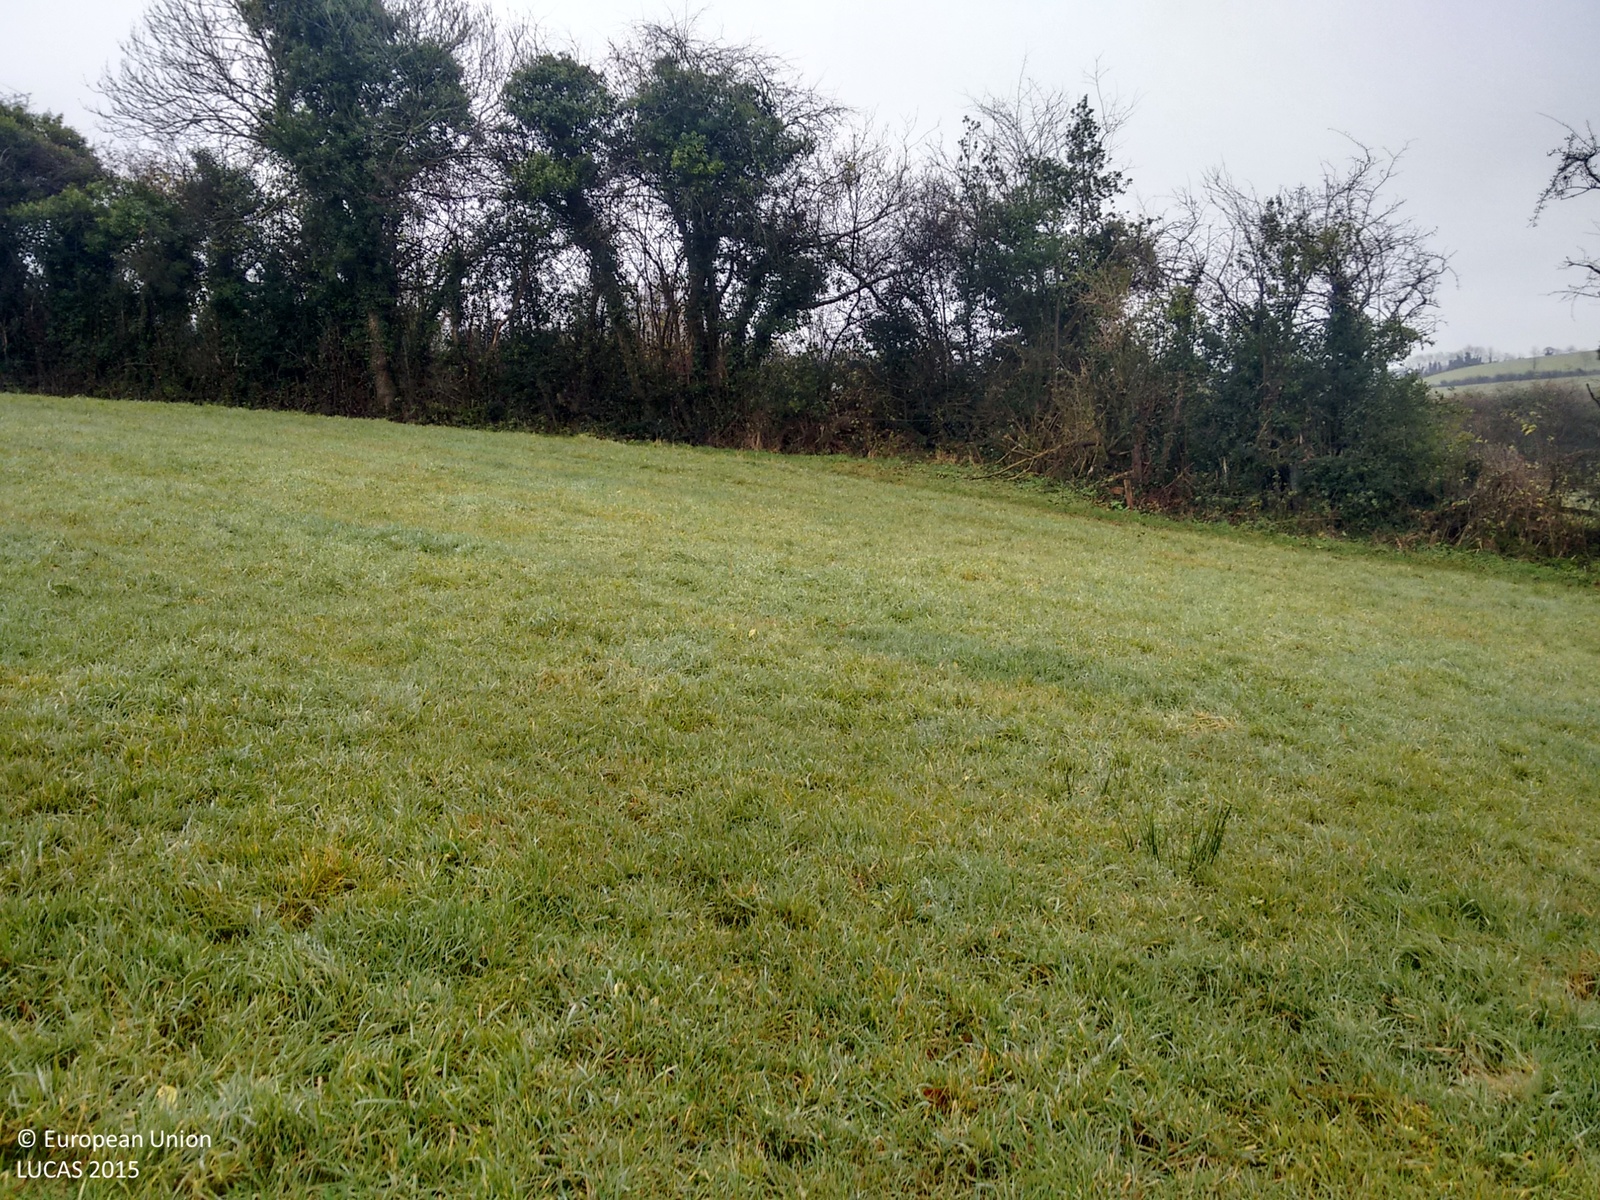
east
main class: Grassland
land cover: Grassland without tree/shrub cover
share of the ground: > 75 %
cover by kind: herbaceous plants 100 %
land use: Agriculture (excluding fallow land and kitchen gardens)
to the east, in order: Grassland without tree/shrub cover; Tracks; Grass margins; Abandoned hedges; Grassland without tree/shrub cover; Fences; Abandoned hedges; Grassland without tree/shrub cover; Fences; Abandoned hedges; Grassland without tree/shrub cover; Fences; Abandoned hedges; Grassland without tree/shrub cover
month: December
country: GB
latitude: 54.2094
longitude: -7.2758
